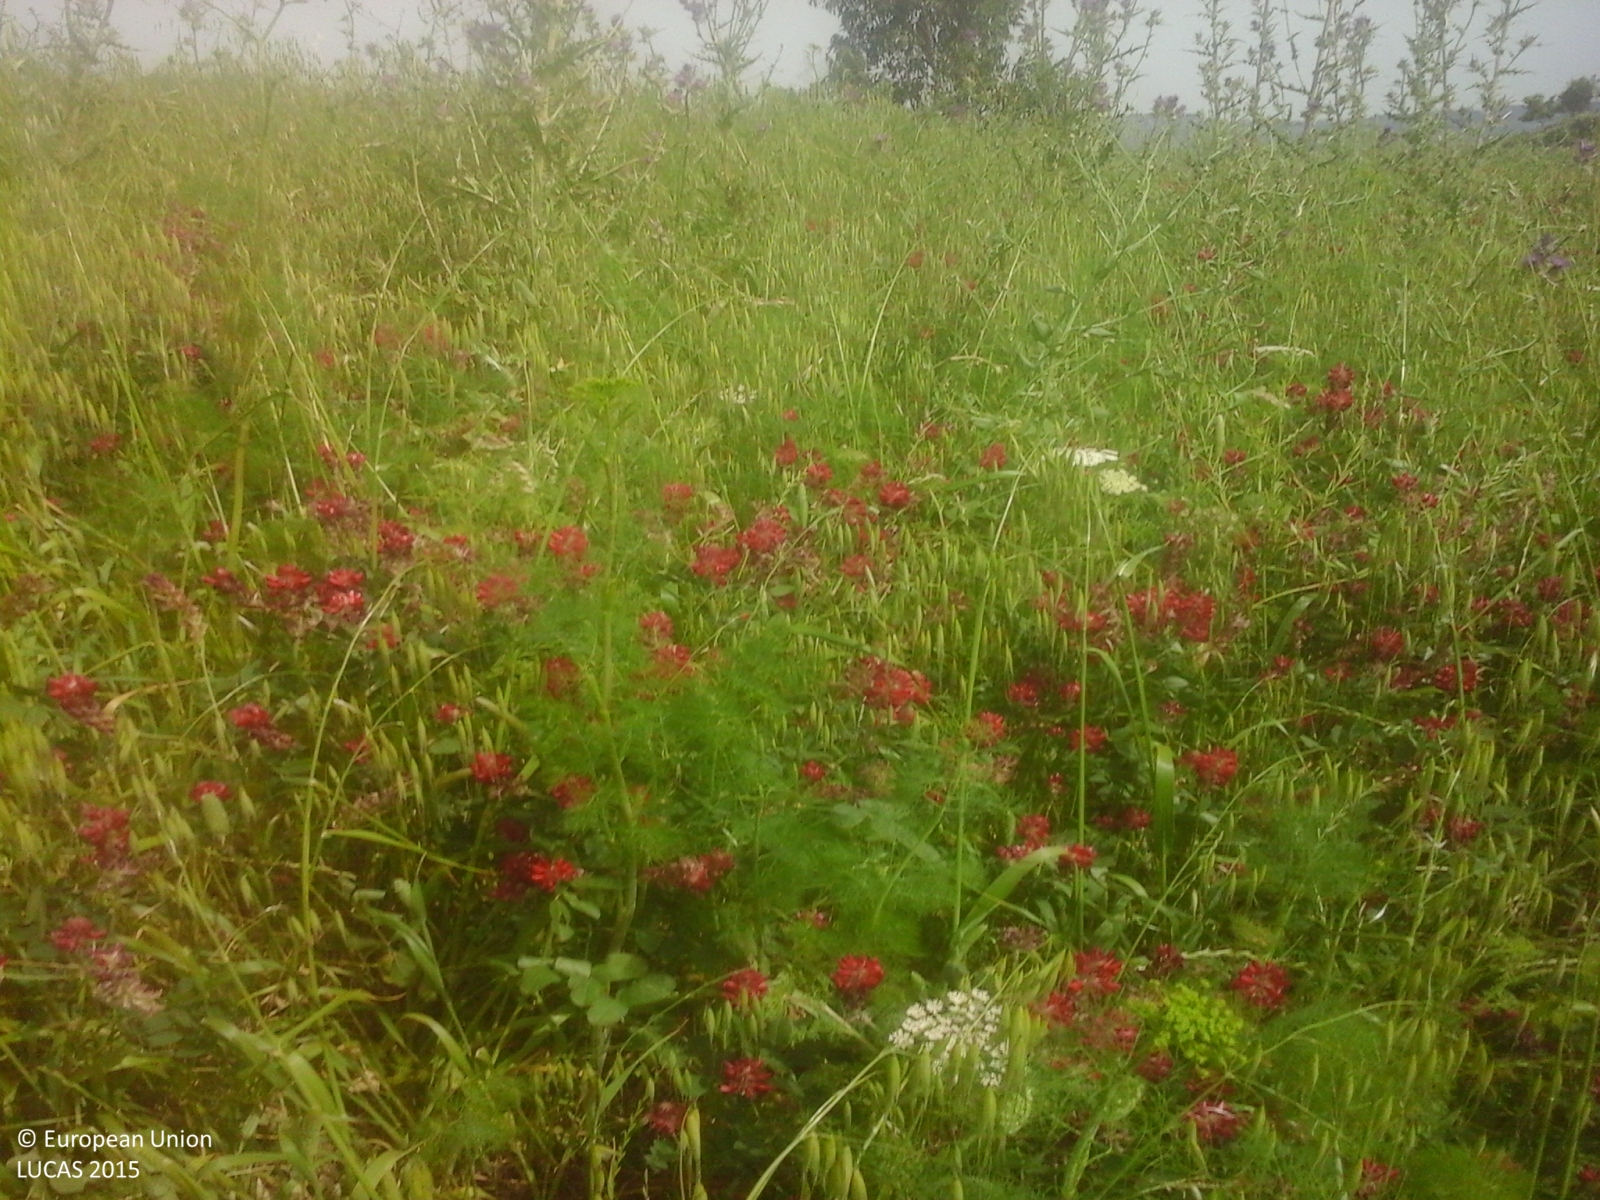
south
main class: Cropland
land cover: Temporary grasslands
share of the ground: > 75 %
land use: Agriculture (excluding fallow land and kitchen gardens)
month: May
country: IT
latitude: 37.5930
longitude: 13.9461
